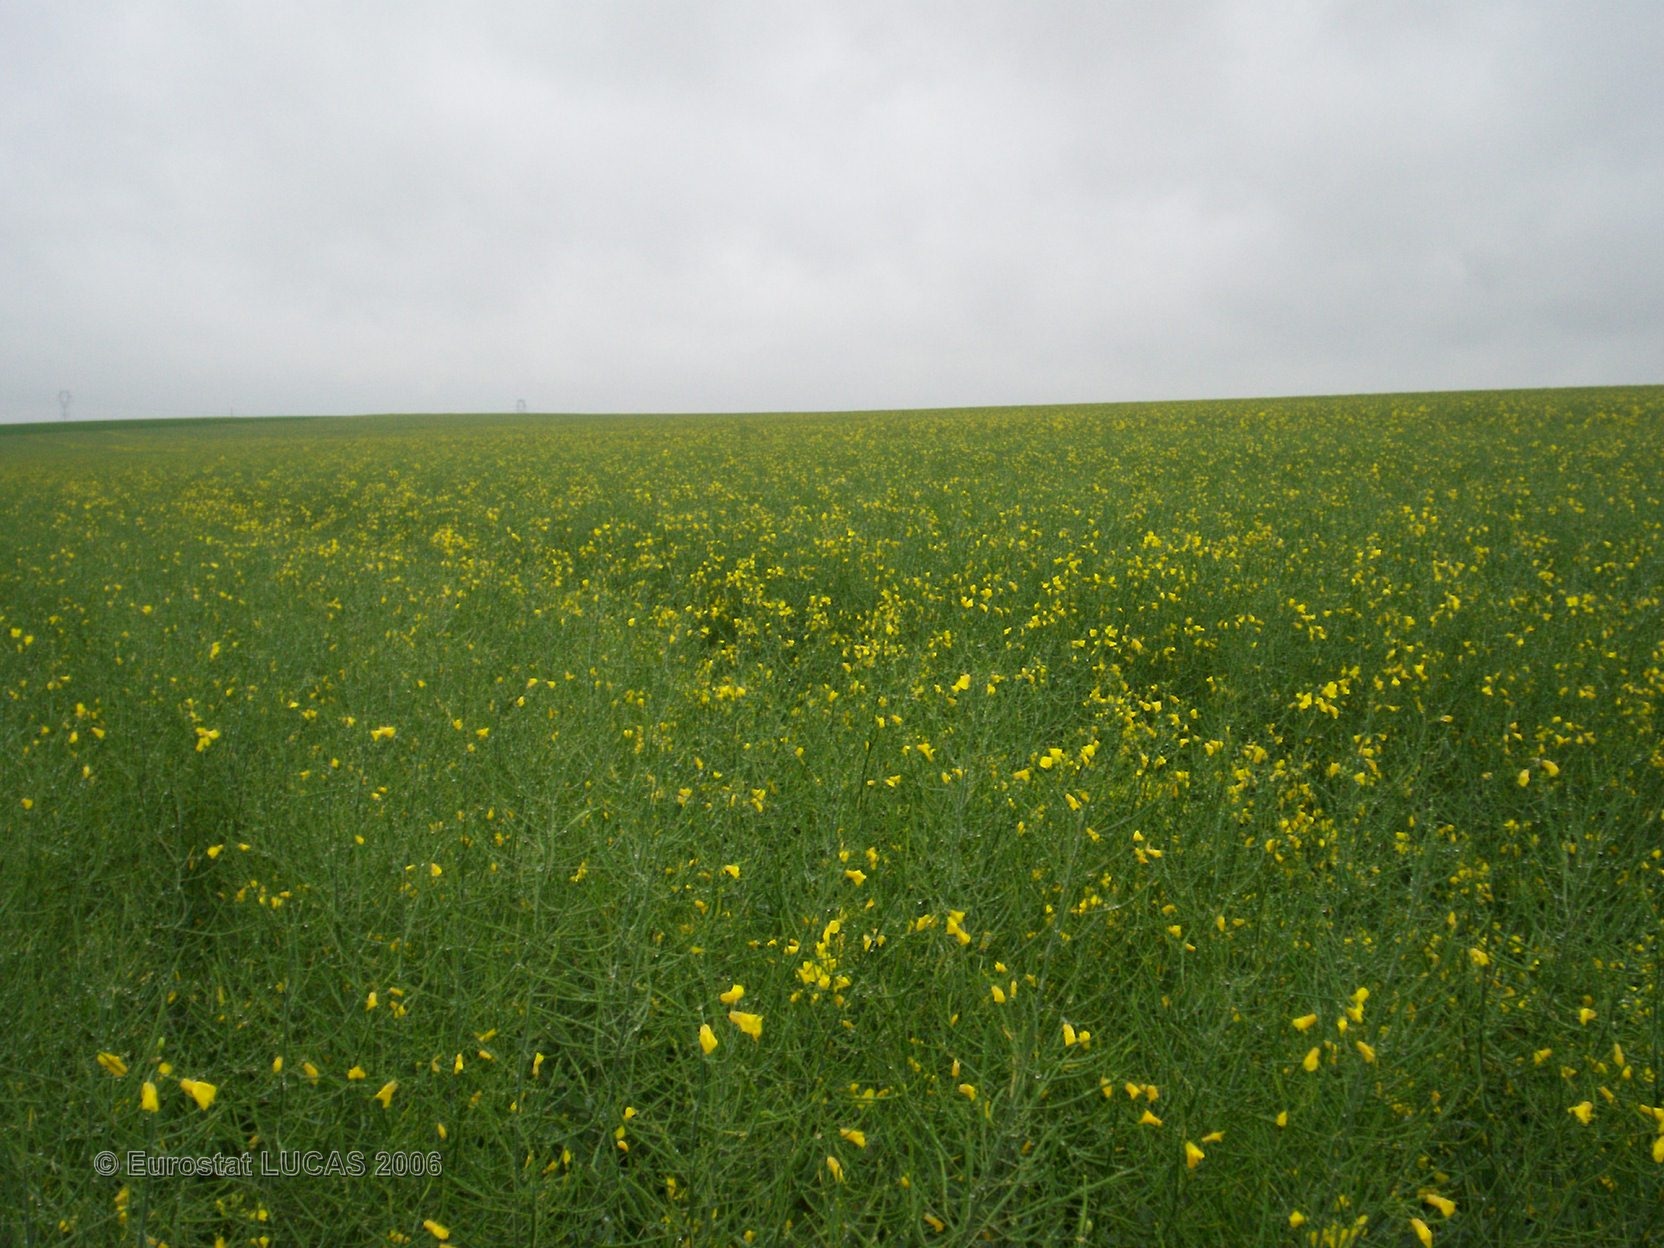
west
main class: Cropland
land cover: Rape and turnip rape
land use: Agriculture (excluding fallow land and kitchen gardens)
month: May
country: FR
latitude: 49.4177
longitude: 4.4409
